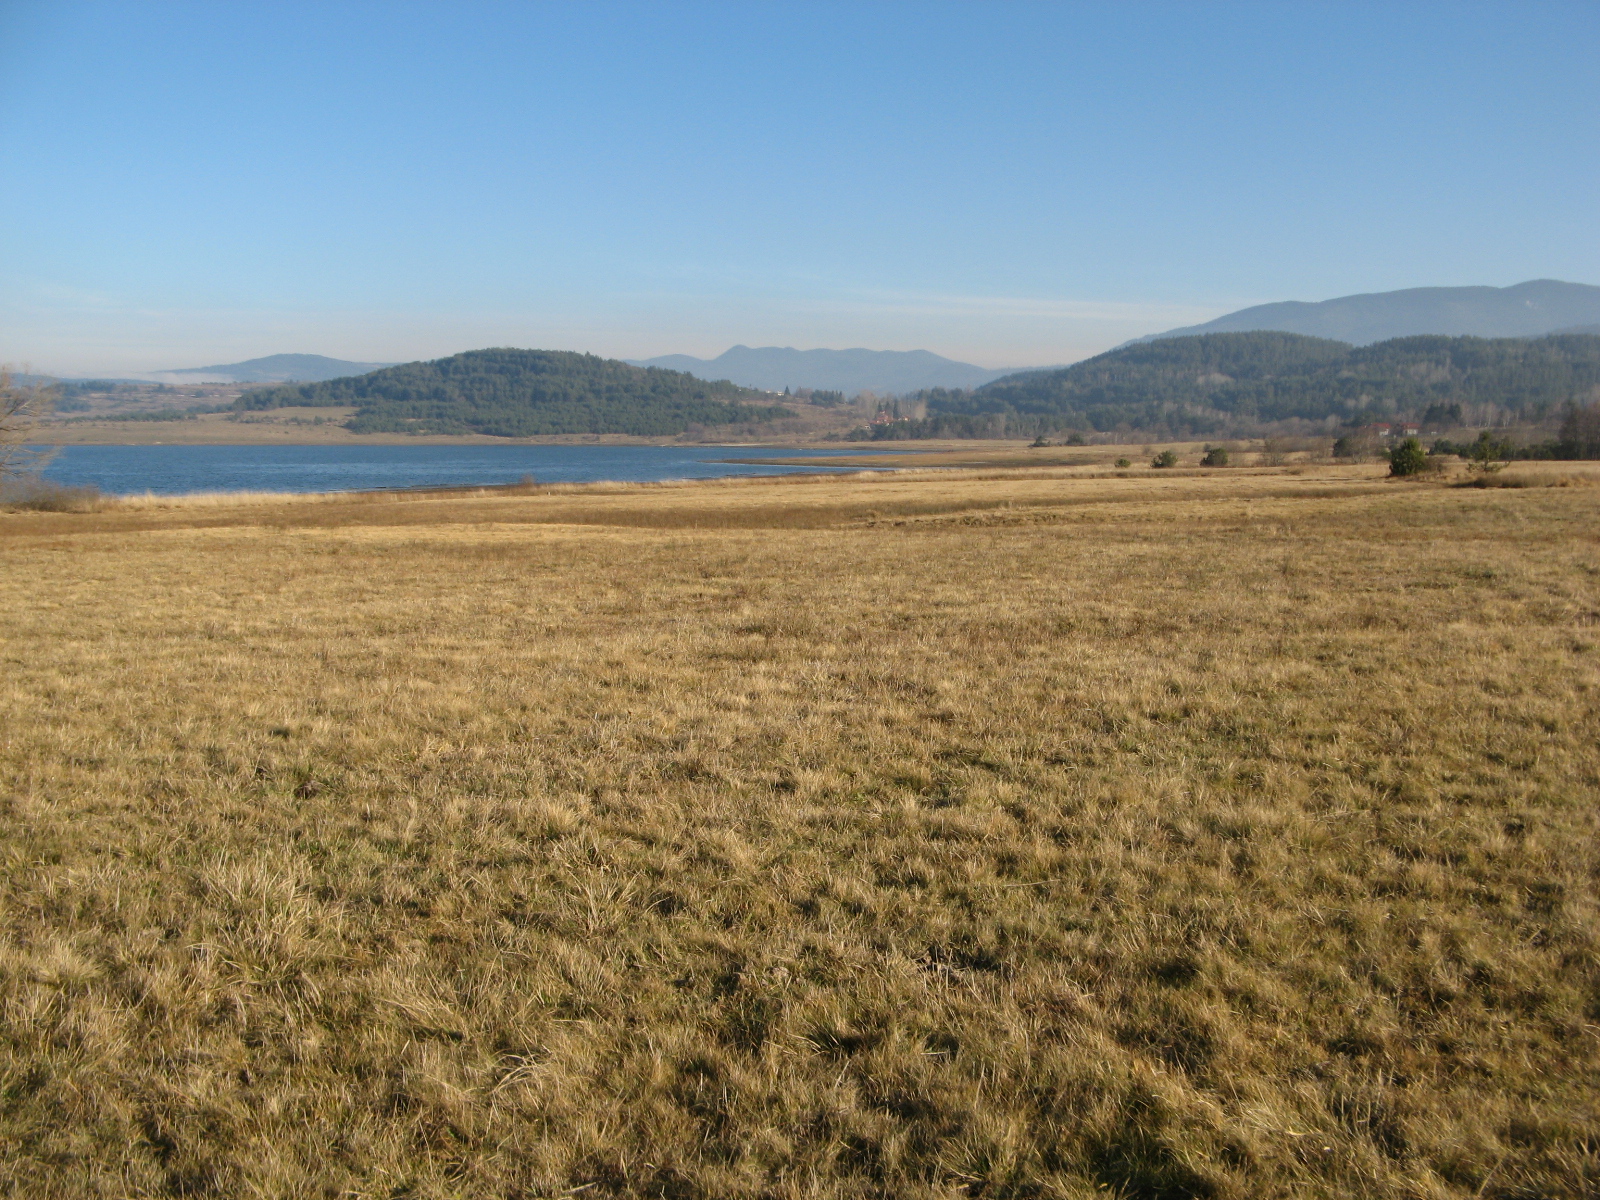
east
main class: Grassland
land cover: Grassland without tree/shrub cover
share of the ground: > 75 %
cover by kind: herbaceous plants 100 %
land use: Agriculture (excluding fallow land and kitchen gardens)
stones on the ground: < 10 %
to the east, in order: Grassland without tree/shrub cover; Other bare soil; Inland fresh water bodies
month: December
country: BG
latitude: 41.9458
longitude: 24.1644
